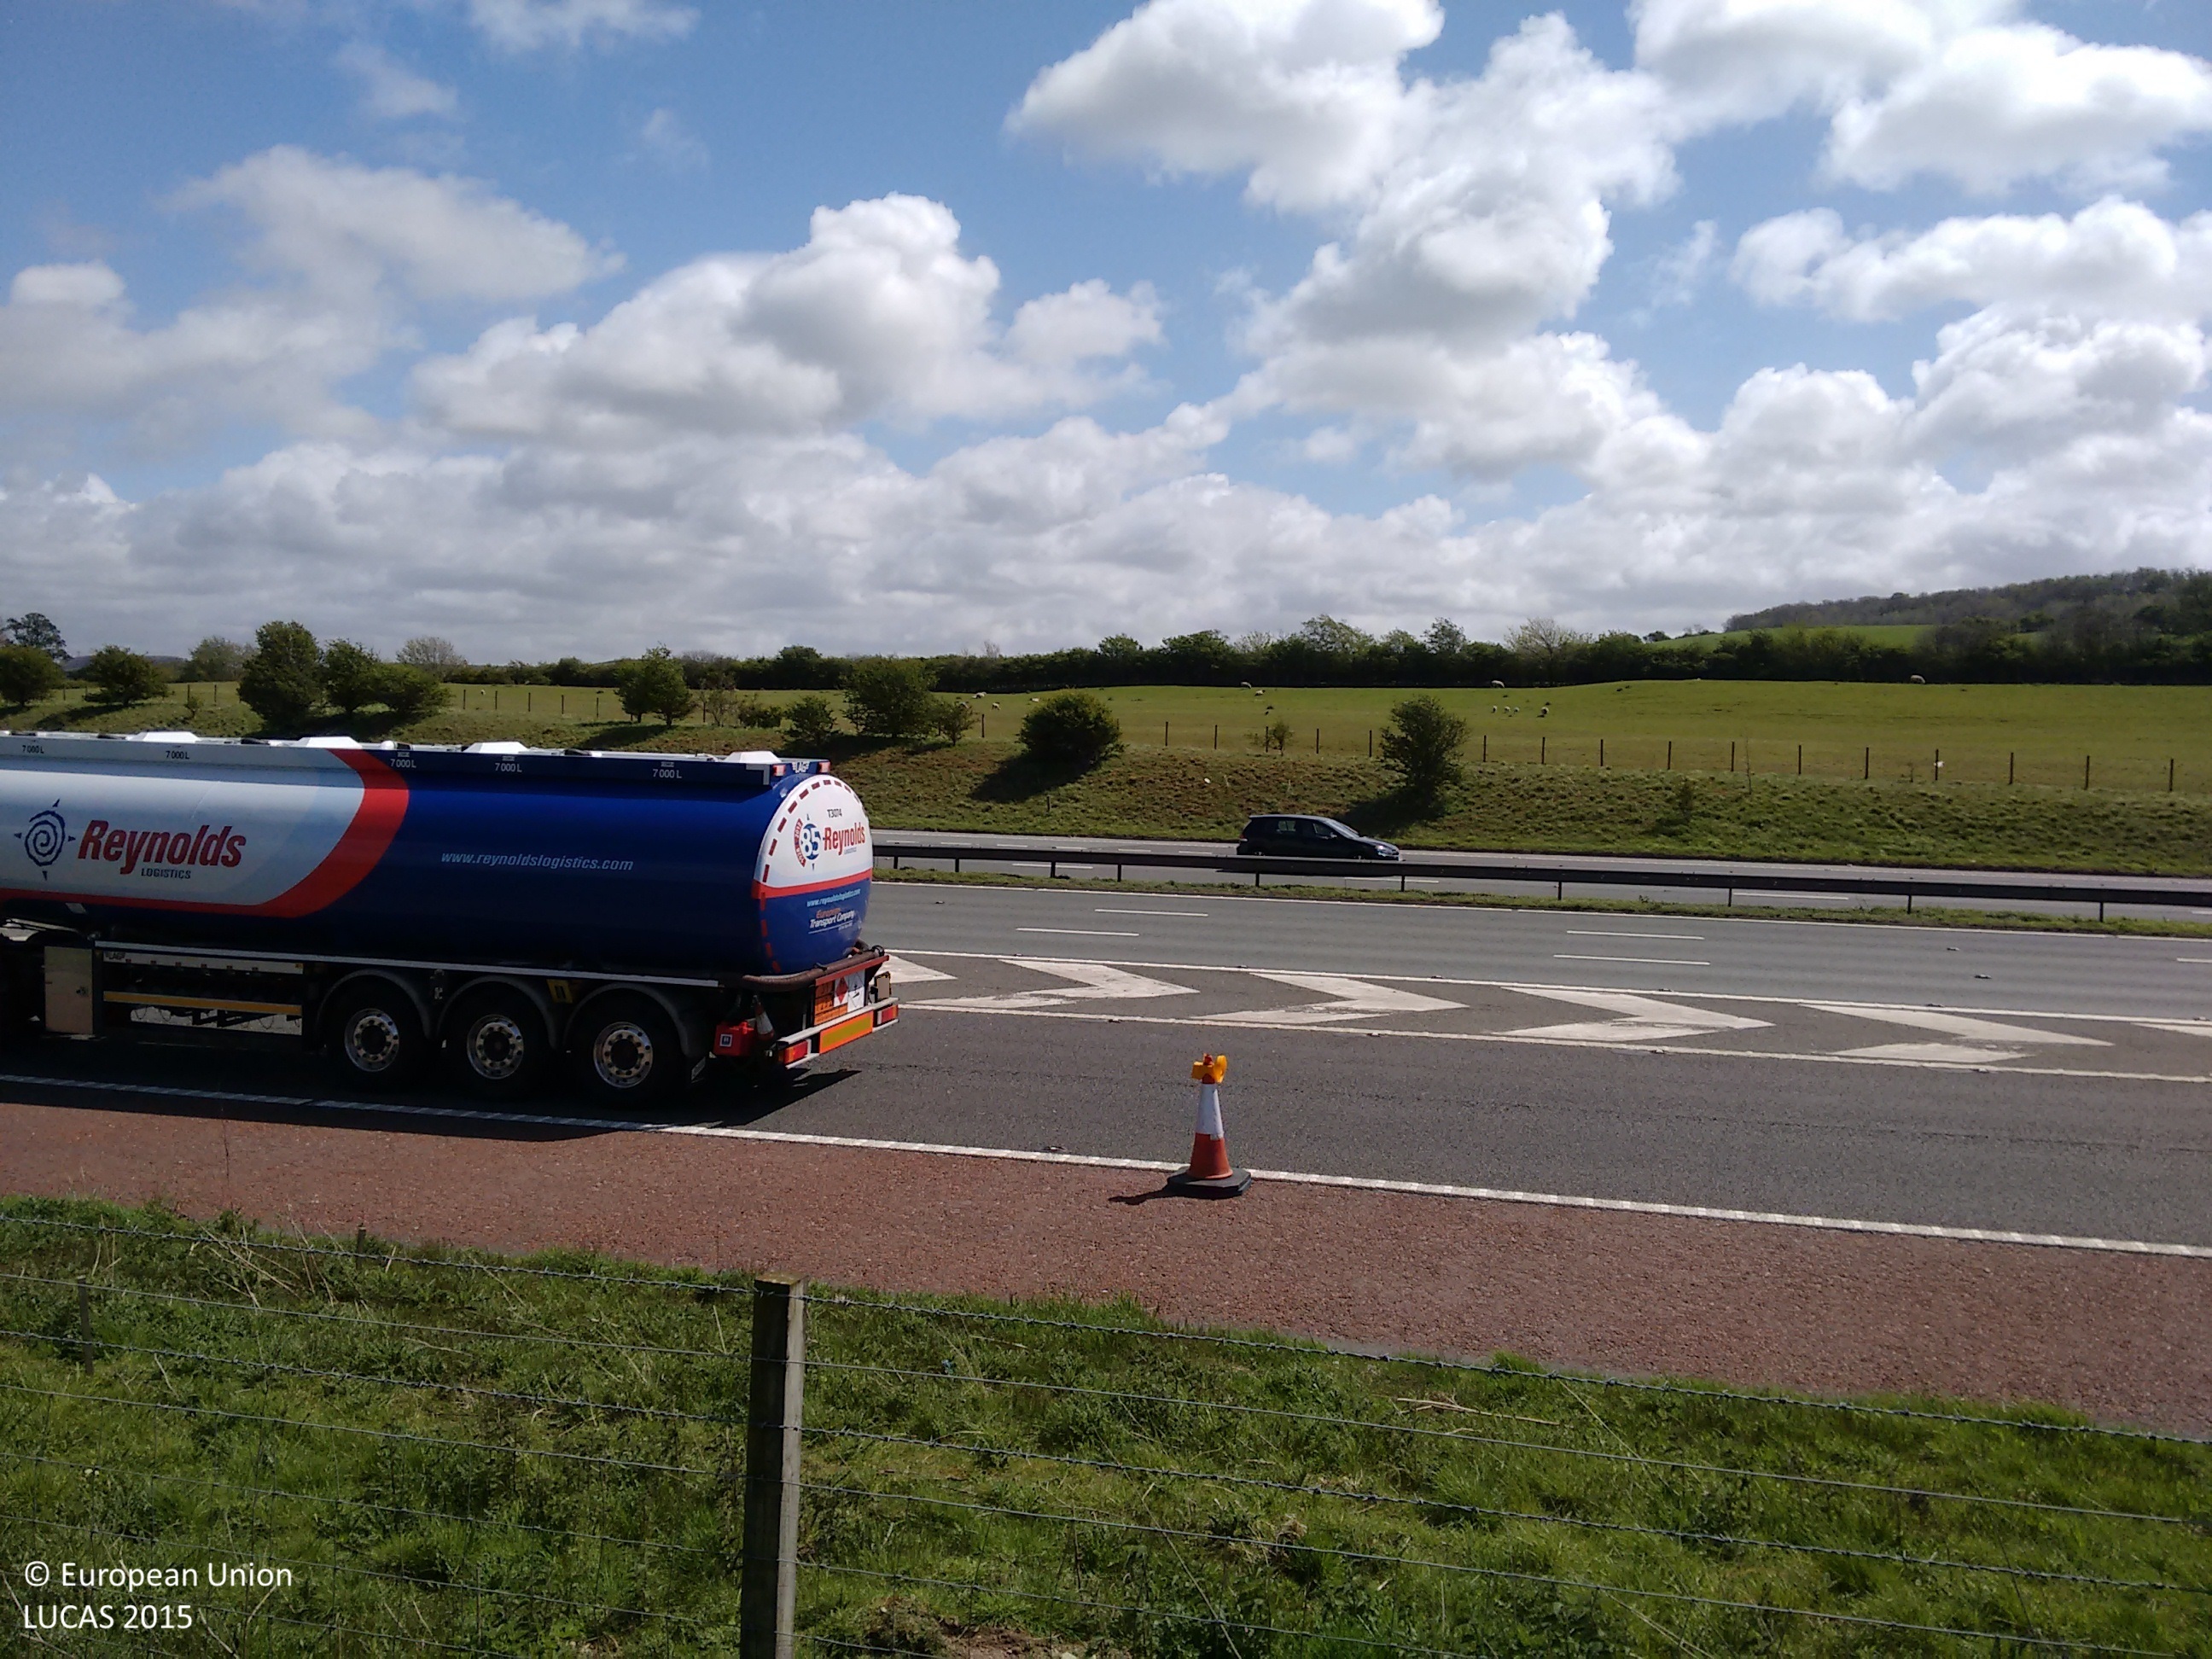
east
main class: Woodland
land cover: Broadleaved woodland
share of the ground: 50 - 75 %
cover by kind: broadleaved forest trees 100 %
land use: Agriculture (excluding fallow land and kitchen gardens)
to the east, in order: Broadleaved woodland; Fences; Grassland without tree/shrub cover; Fences; Grass margins; Paved roads, cycling and walking lanes; Grass margins; Fences; Grassland without tree/shrub cover
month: May
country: GB
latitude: 54.1266
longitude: -2.7543
